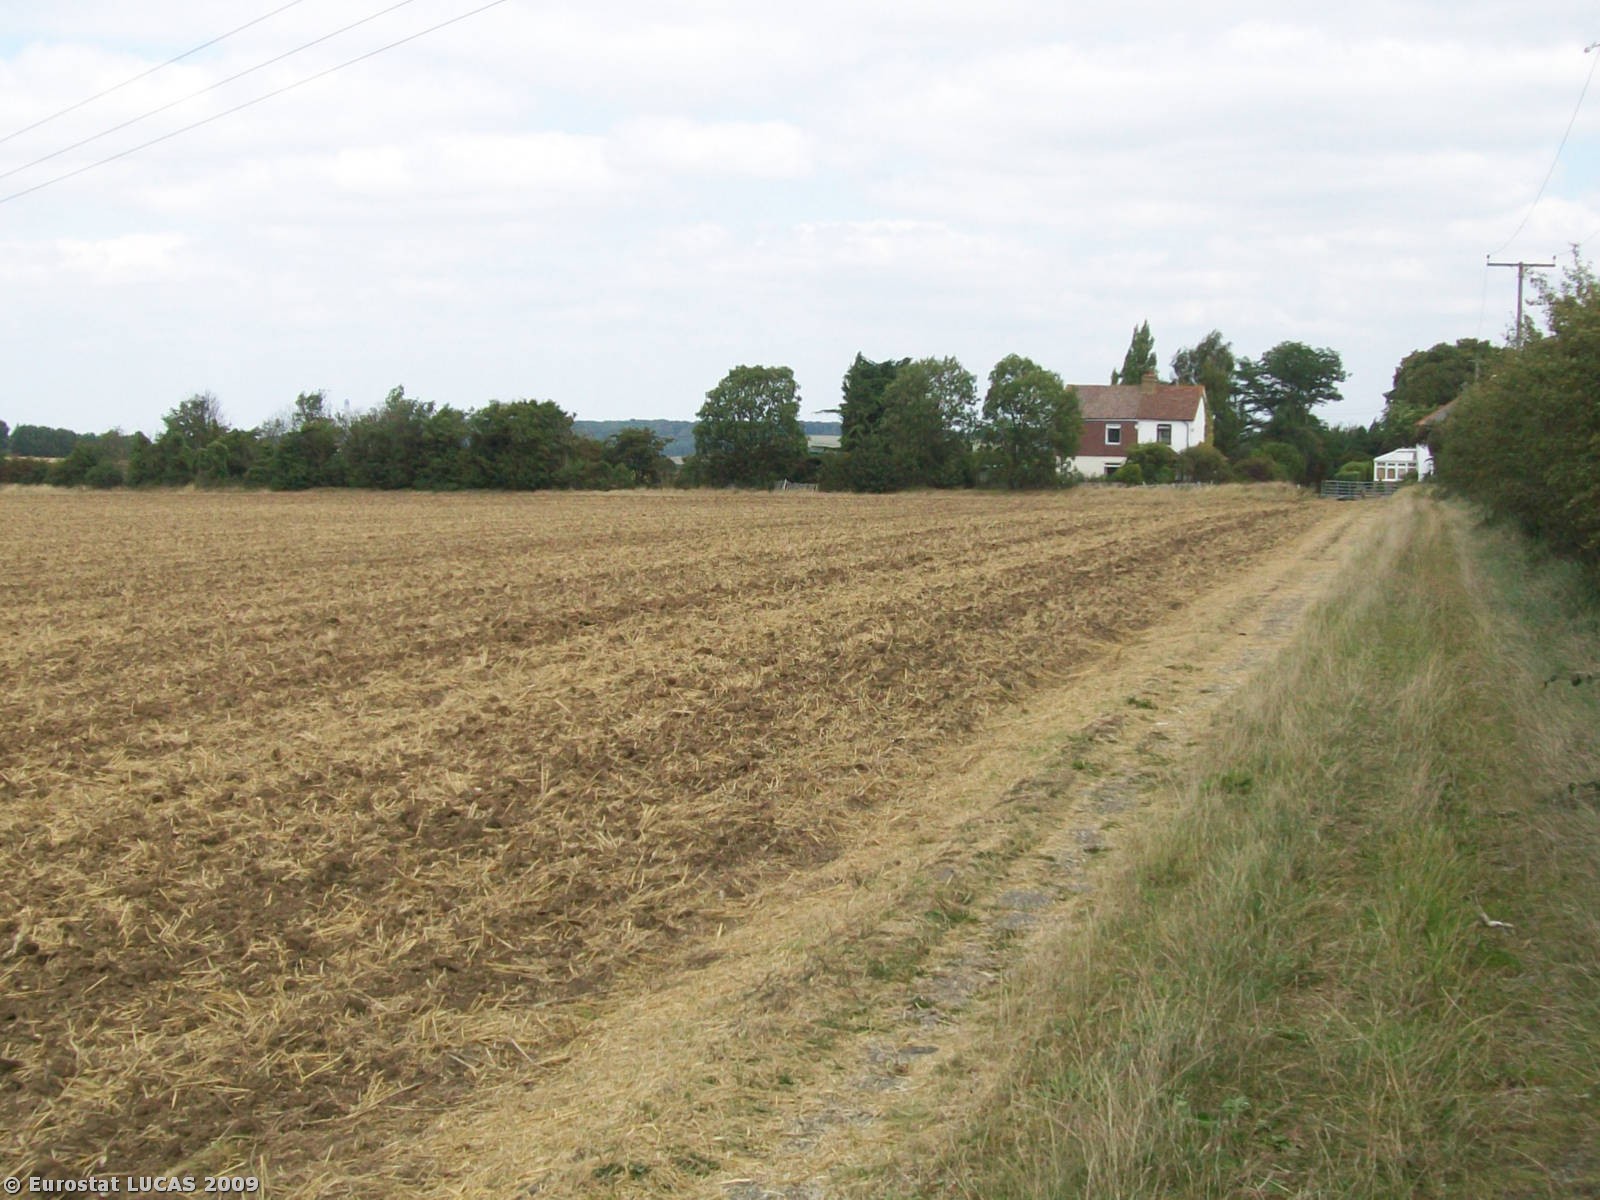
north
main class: Cropland
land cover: Common wheat
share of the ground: < 10 %
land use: Agriculture (excluding fallow land and kitchen gardens)
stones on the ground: 10 - 25 %
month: August
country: GB
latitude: 51.3972
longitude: 0.2680
